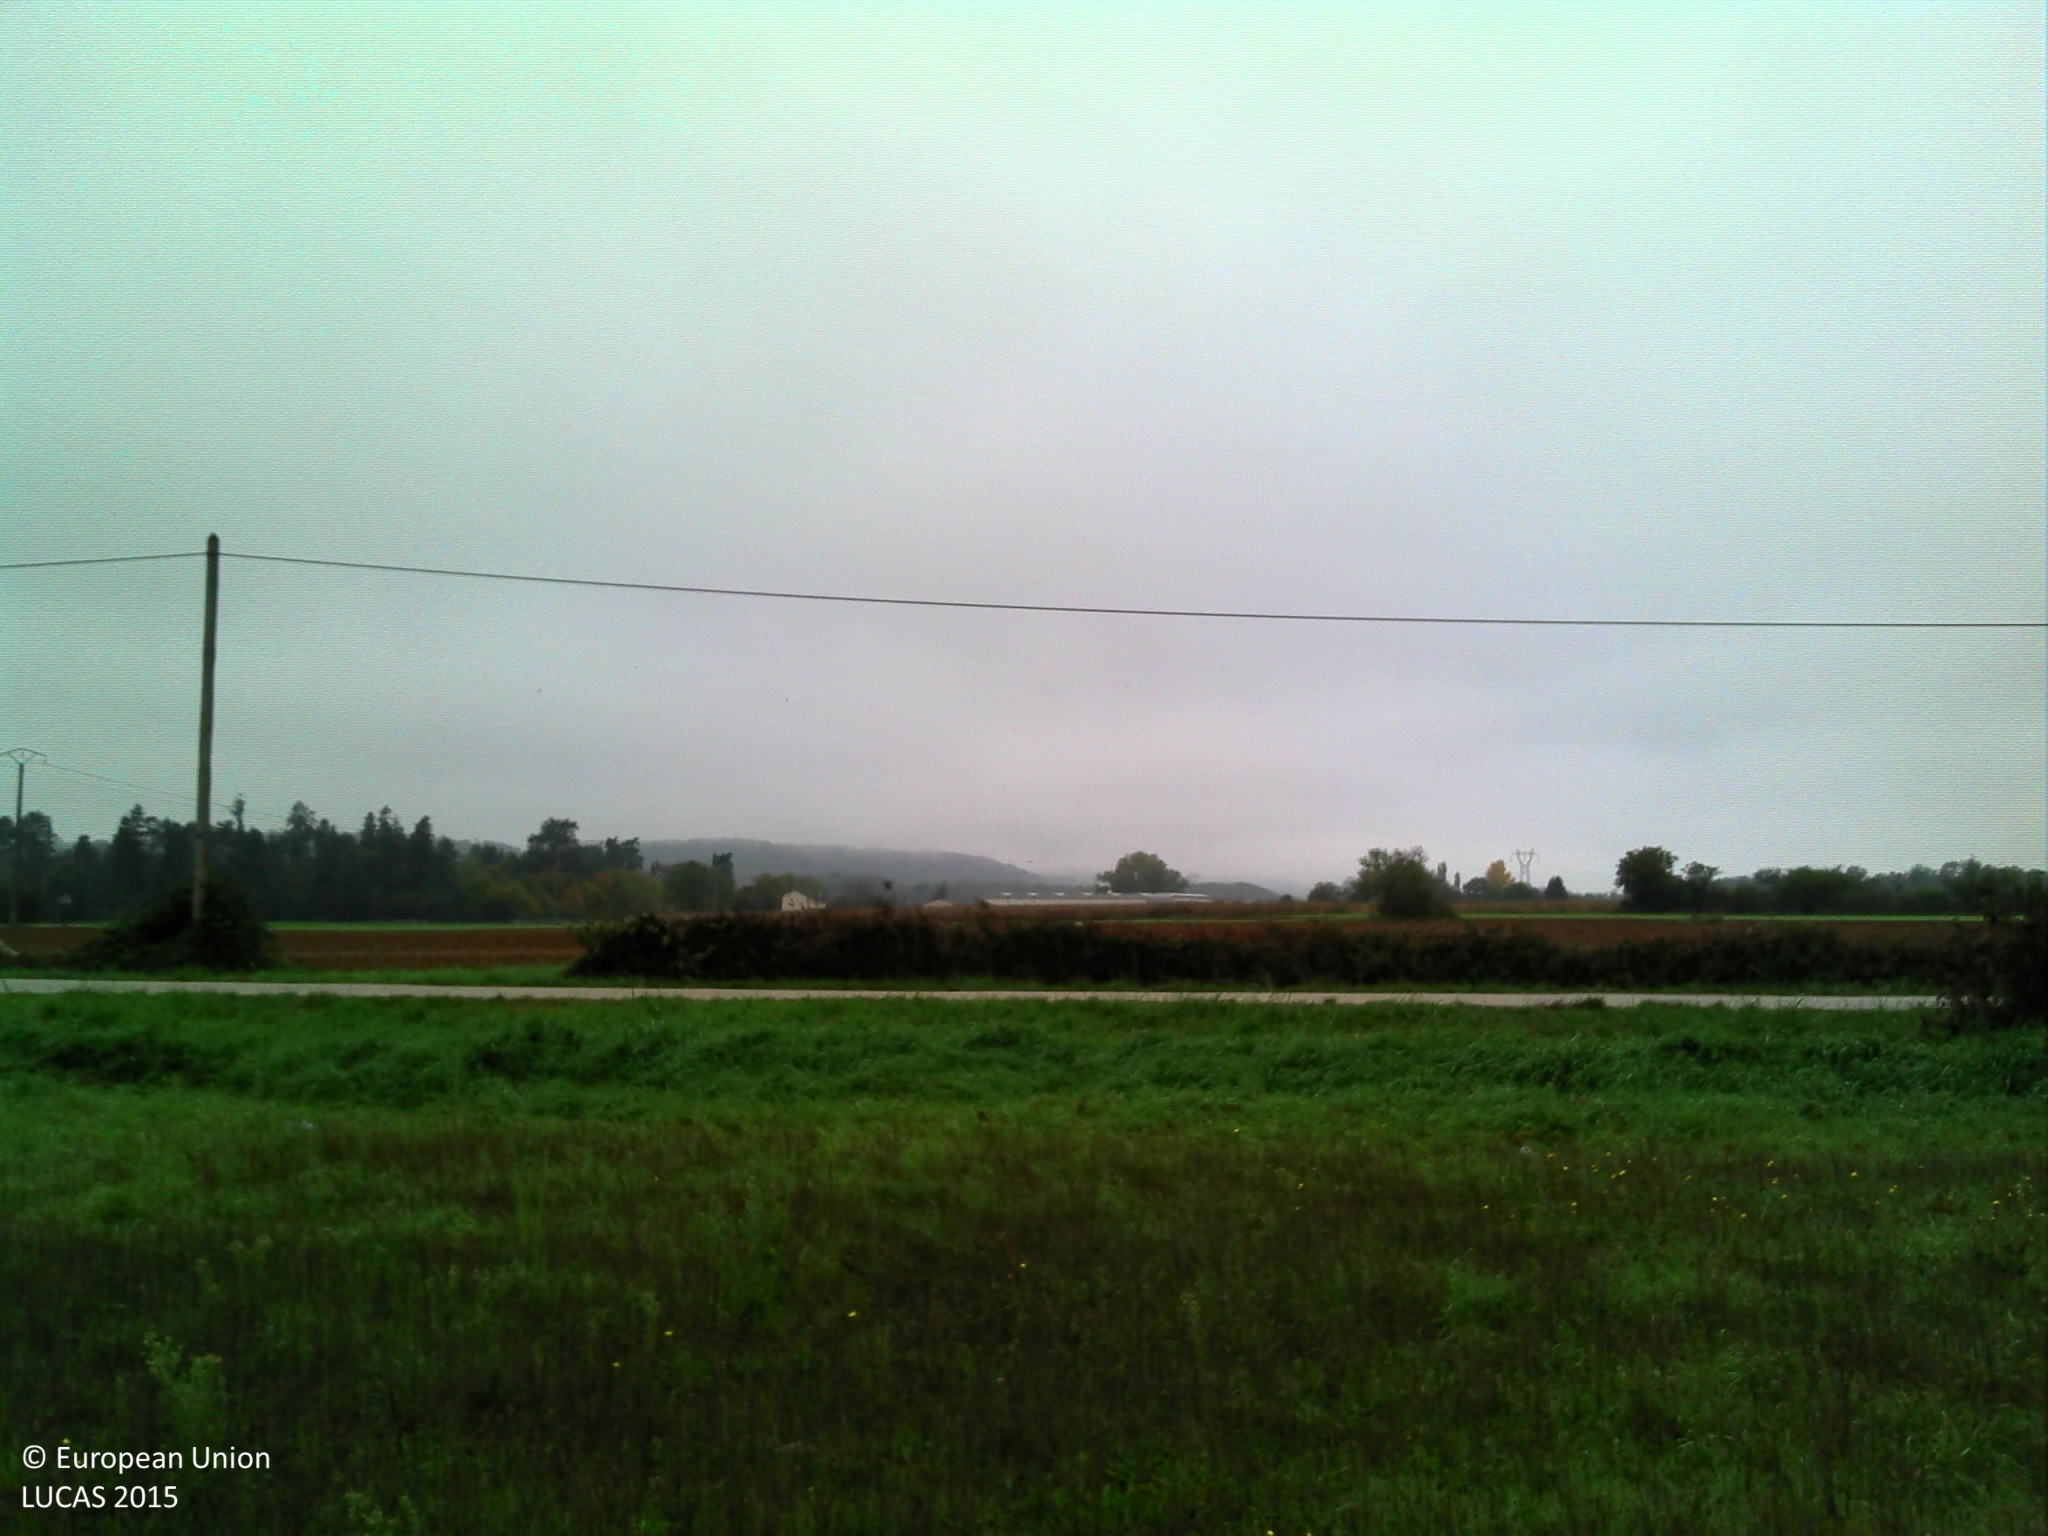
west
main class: Grassland
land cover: Spontaneously vegetated surfaces
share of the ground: > 75 %
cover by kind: herbaceous plants 100 %
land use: Agriculture (excluding fallow land and kitchen gardens)
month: October
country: FR
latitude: 45.8387
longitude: 5.4332
